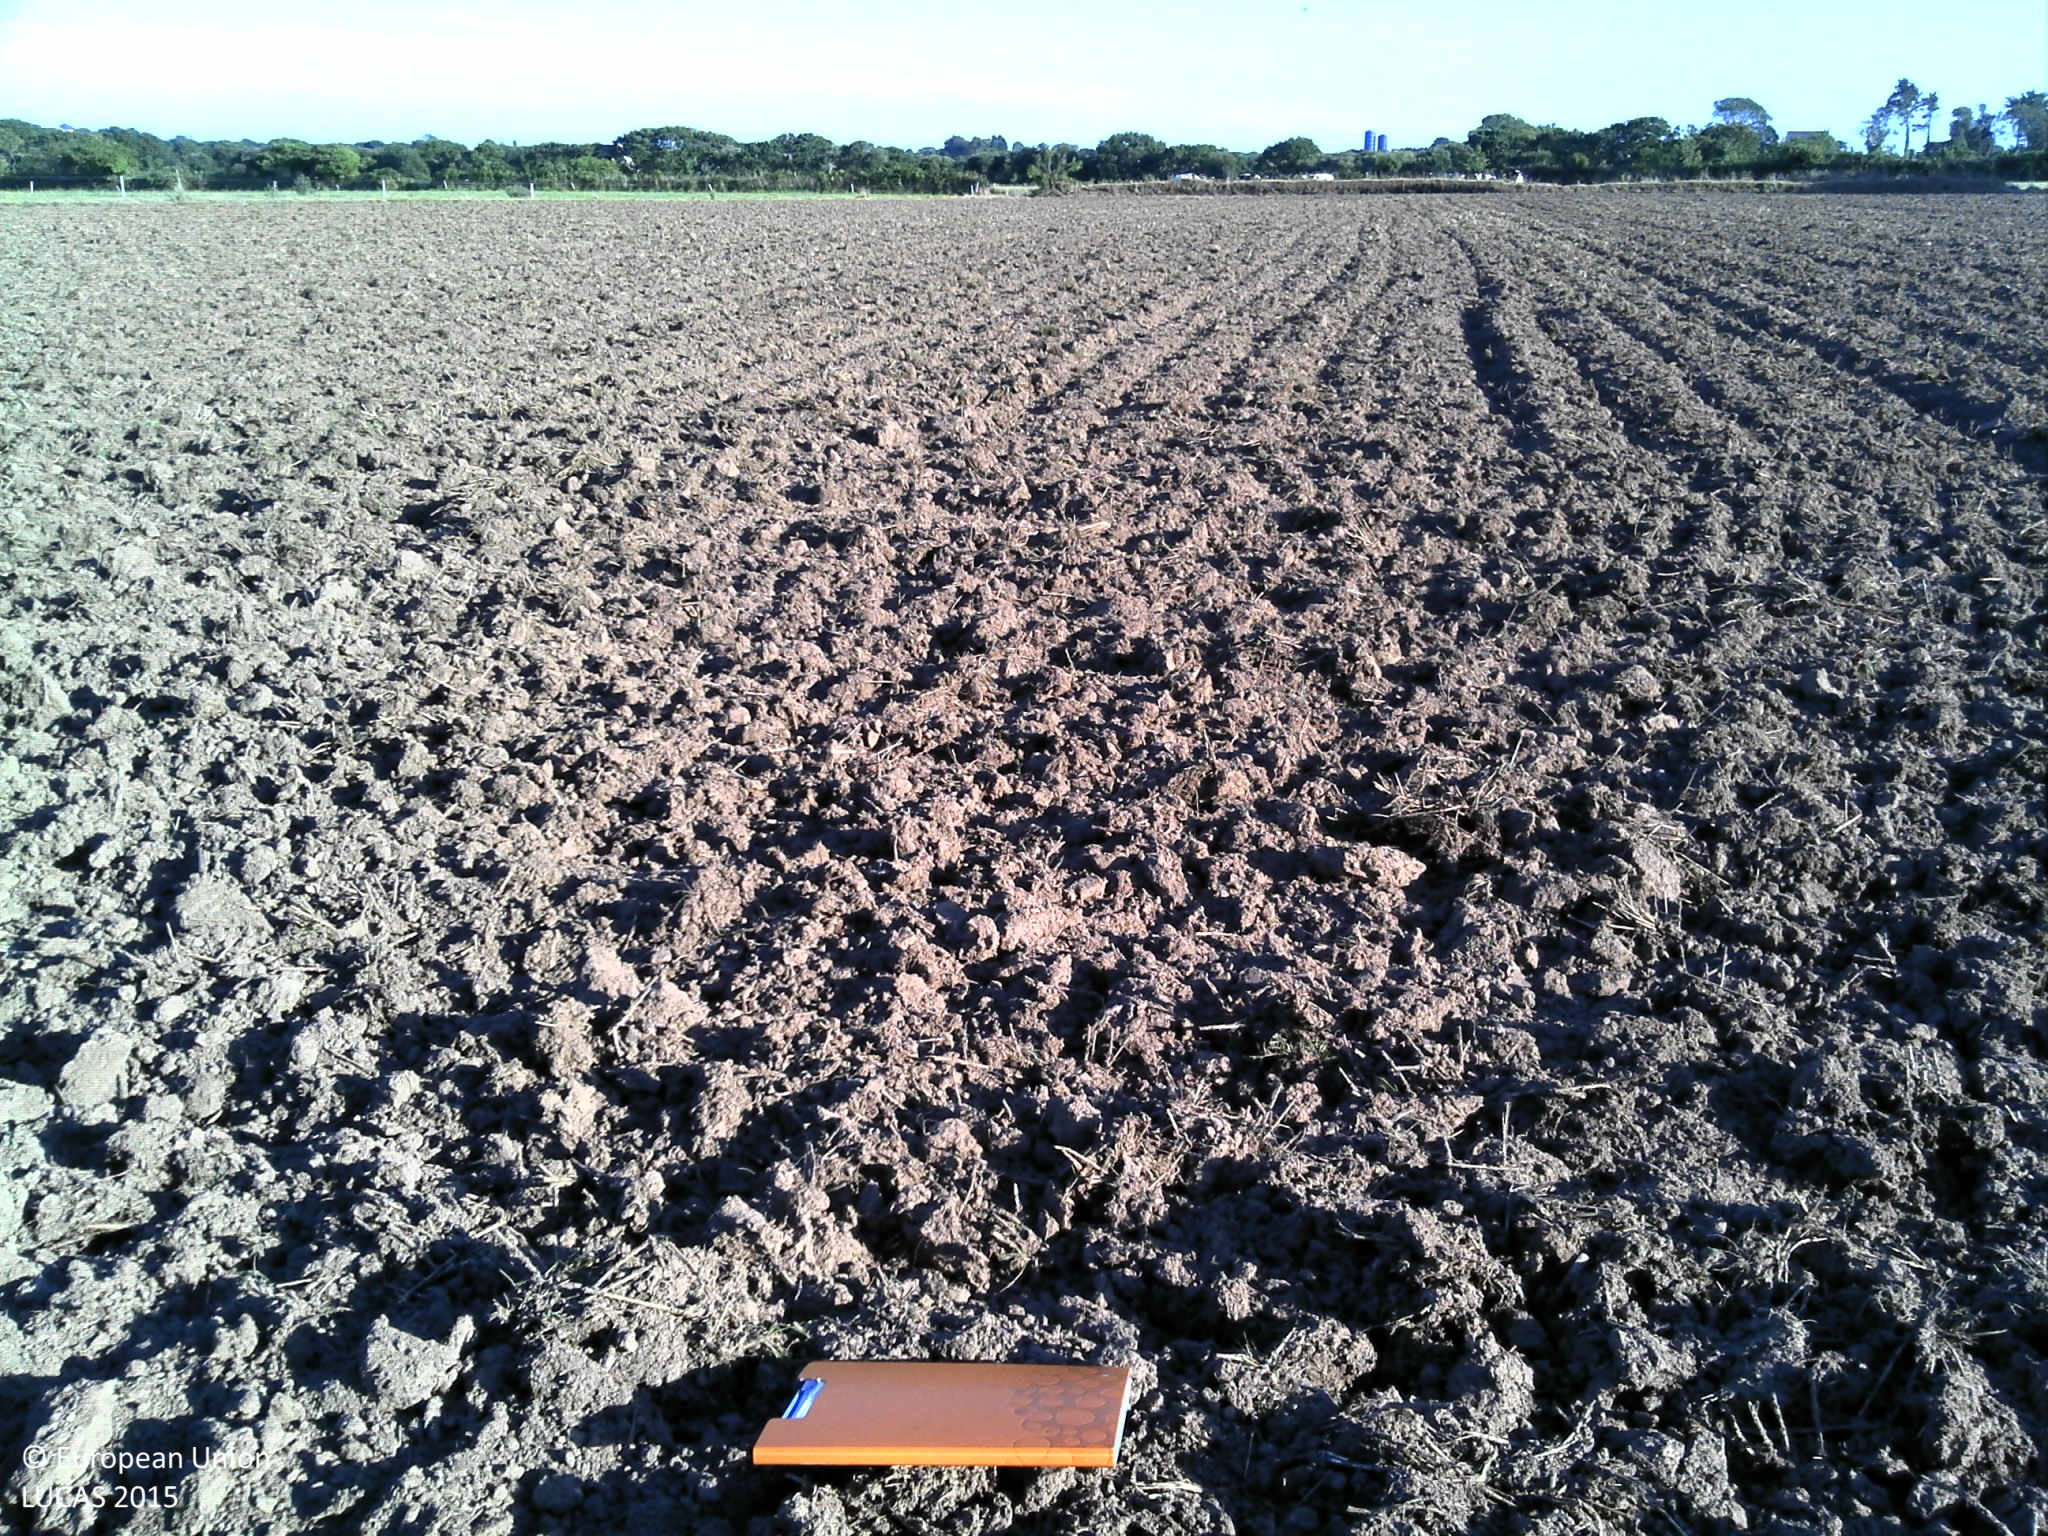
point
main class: Cropland
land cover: Barley
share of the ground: < 10 %
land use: Agriculture (excluding fallow land and kitchen gardens)
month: July
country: FR
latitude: 48.5032
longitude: -4.4860
